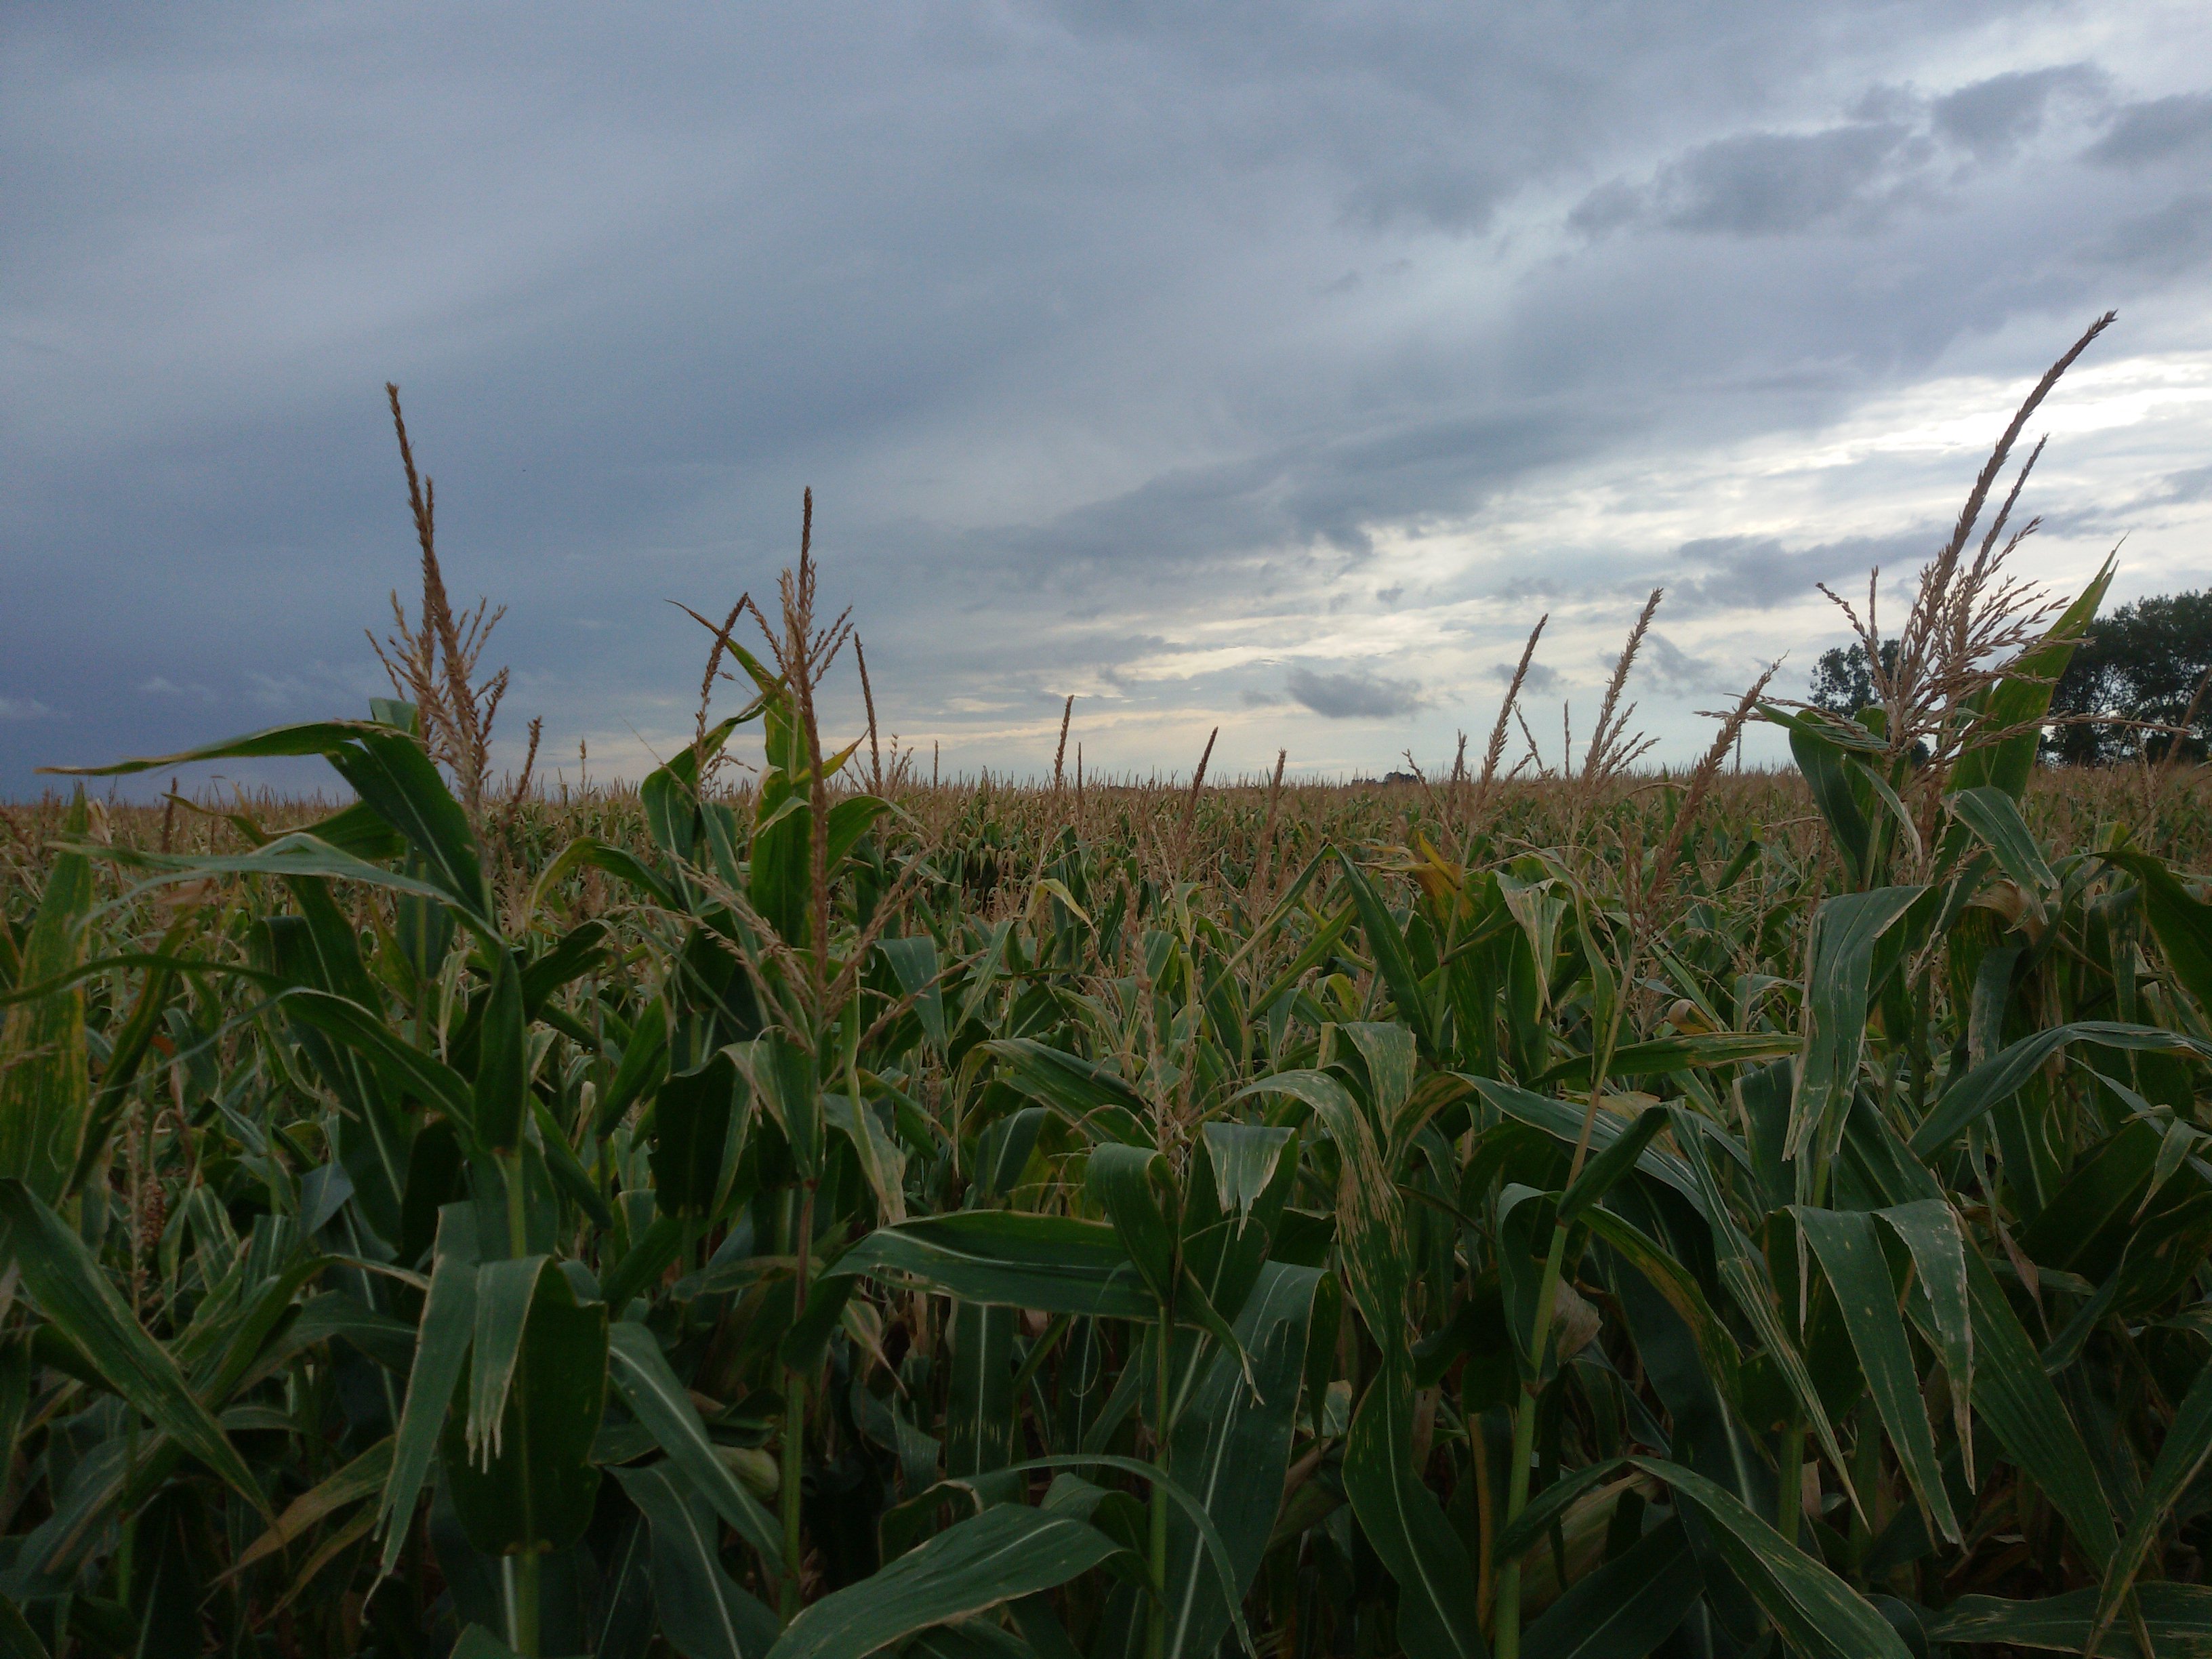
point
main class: Cropland
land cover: Maize
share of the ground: > 75 %
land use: Agriculture (excluding fallow land and kitchen gardens)
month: August
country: PL
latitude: 51.8789
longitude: 17.9031
